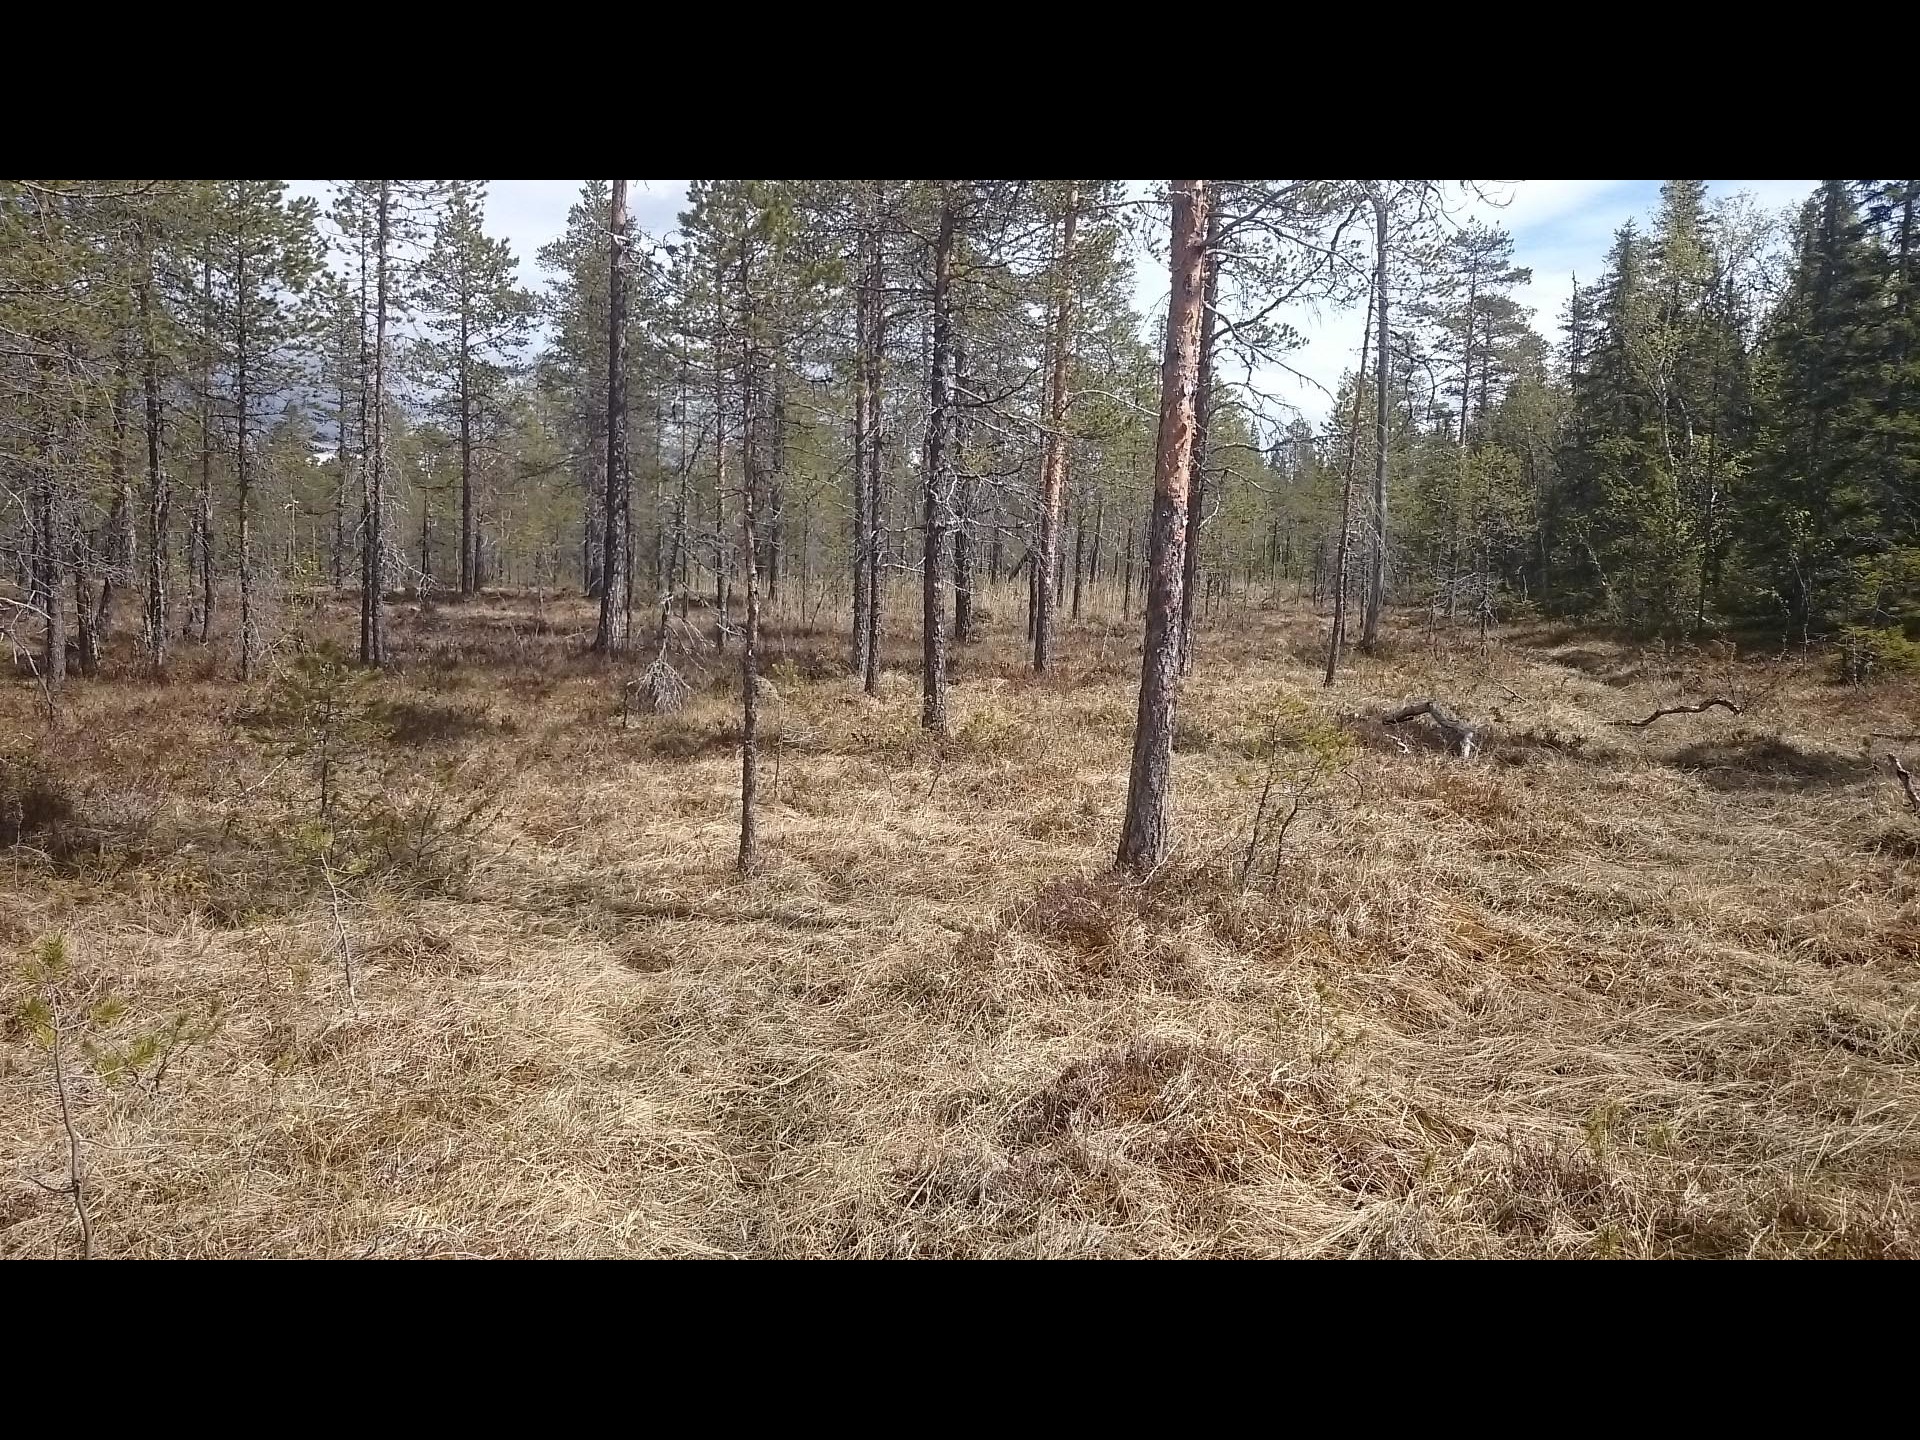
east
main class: Woodland
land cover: Pine dominated coniferous woodland
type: boreal forest
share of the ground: 50 - 75 %
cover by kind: coniferous forest trees 75 %, shrubs 25 %
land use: Forestry
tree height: > 5 m
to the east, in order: Pine dominated coniferous woodland; Spruce dominated mixed woodland; Spruce dominated coniferous woodland; Spruce dominated mixed woodland
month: June
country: SE
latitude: 63.5929
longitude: 13.8292
